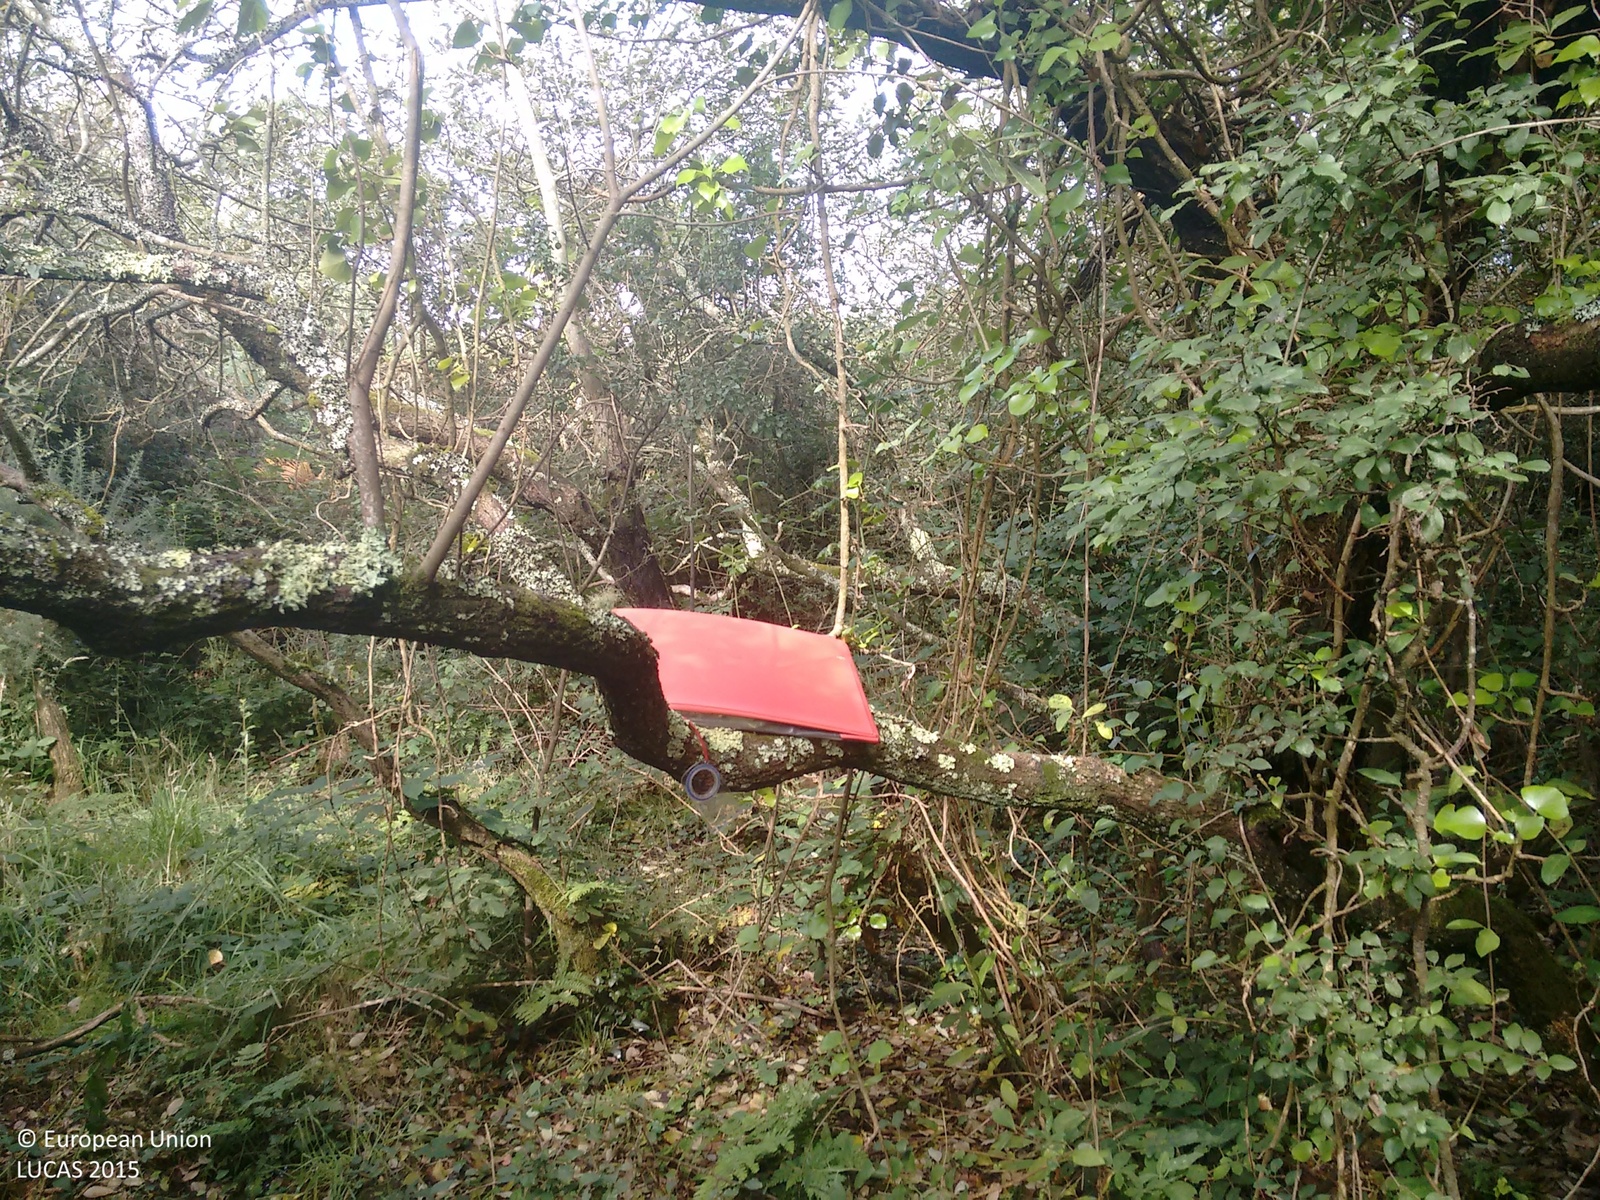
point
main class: Woodland
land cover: Broadleaved woodland
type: mesophytic deciduous forest
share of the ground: > 75 %
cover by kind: broadleaved forest trees 100 %
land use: Forestry
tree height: > 5 m
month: August
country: GB
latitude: 49.9990
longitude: -5.2007
